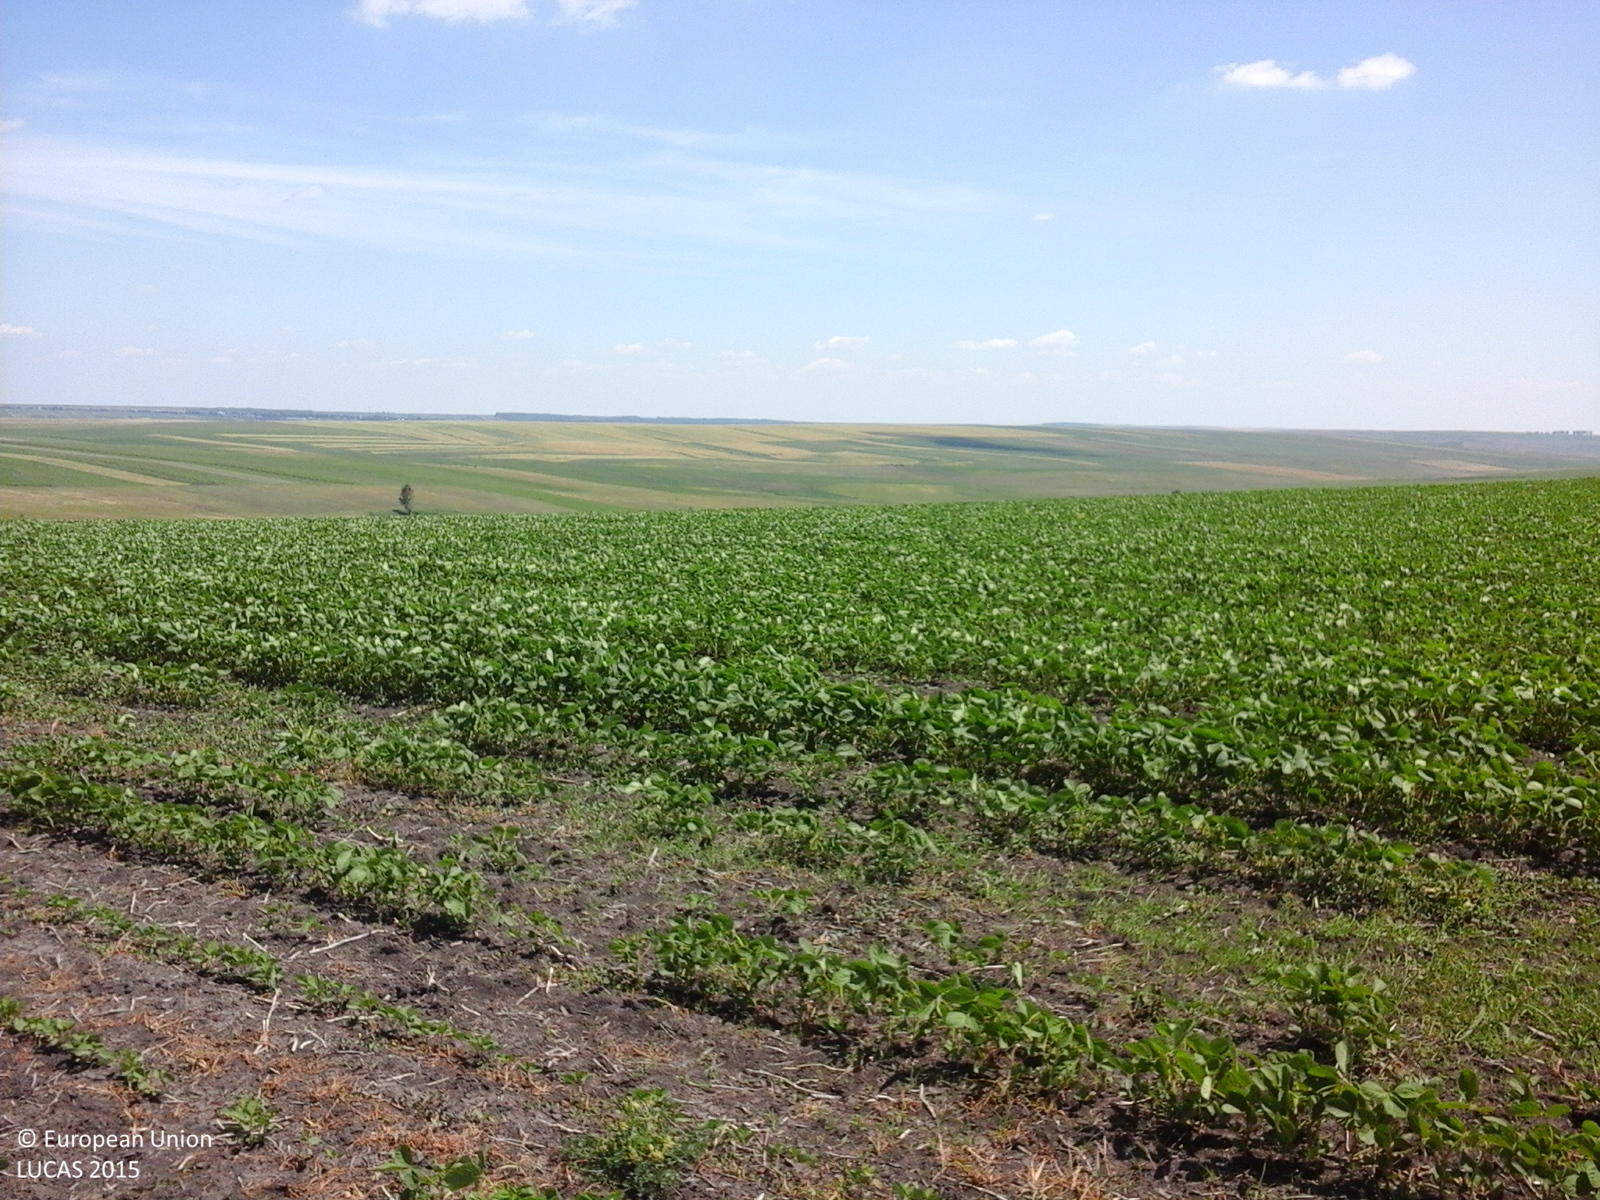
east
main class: Cropland
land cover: Soya
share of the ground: 10 - 25 %
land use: Agriculture (excluding fallow land and kitchen gardens)
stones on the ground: < 10 %
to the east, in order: Soya; Grassland without tree/shrub cover; Tracks; Grassland without tree/shrub cover; Soya
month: June
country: RO
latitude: 48.1248
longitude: 26.7457
